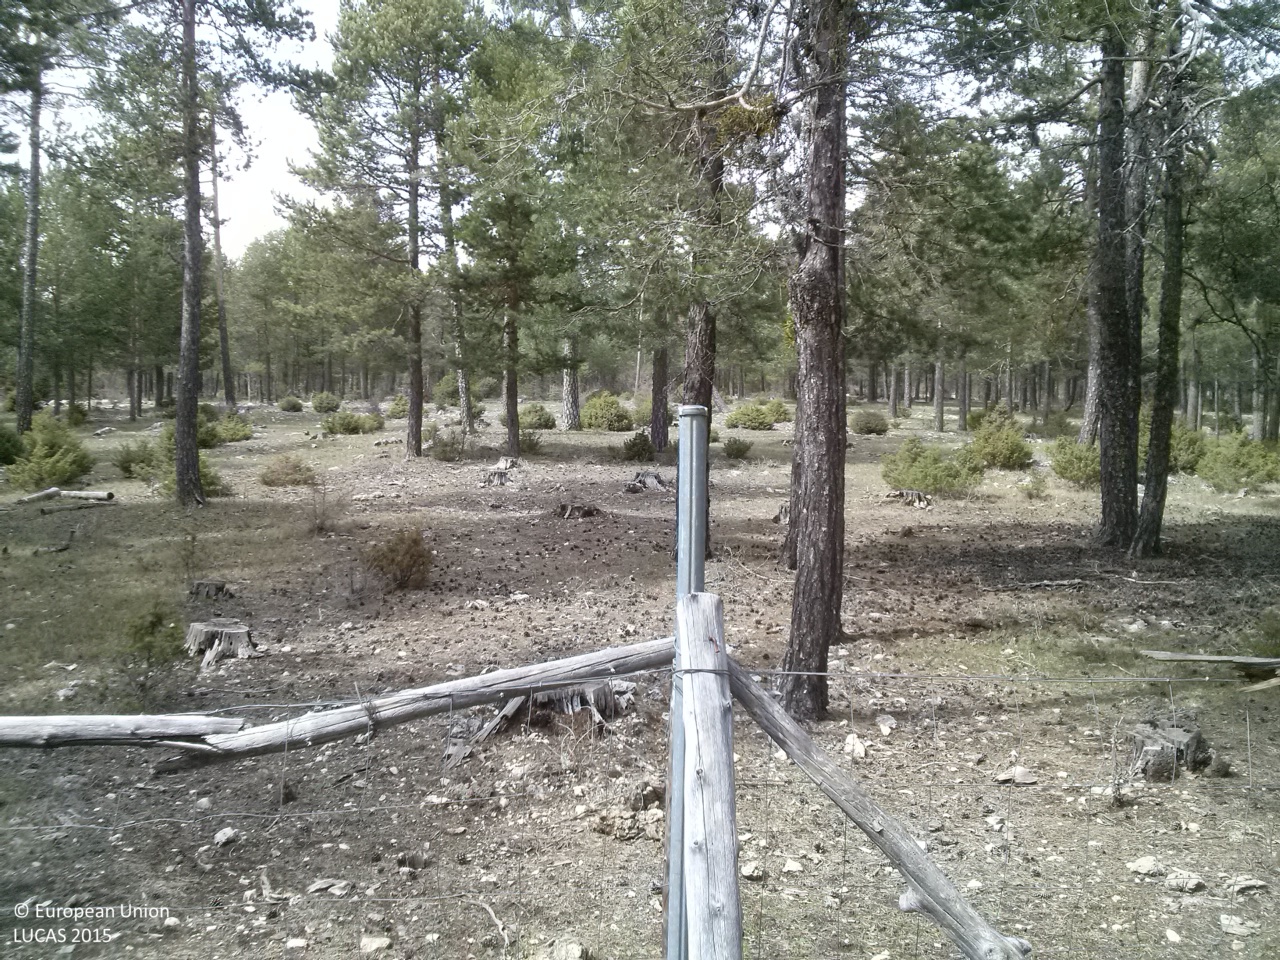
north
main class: Woodland
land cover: Pine dominated coniferous woodland
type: coniferous forest of the mediterranean region
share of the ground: 50 - 75 %
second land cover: Grassland without tree/shrub cover
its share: > 75 %
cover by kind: coniferous forest trees 50 %, herbaceous plants 50 %
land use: Forestry
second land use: Agriculture (excluding fallow land and kitchen gardens)
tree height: > 5 m
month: April
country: ES
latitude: 40.2882
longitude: -1.9085
